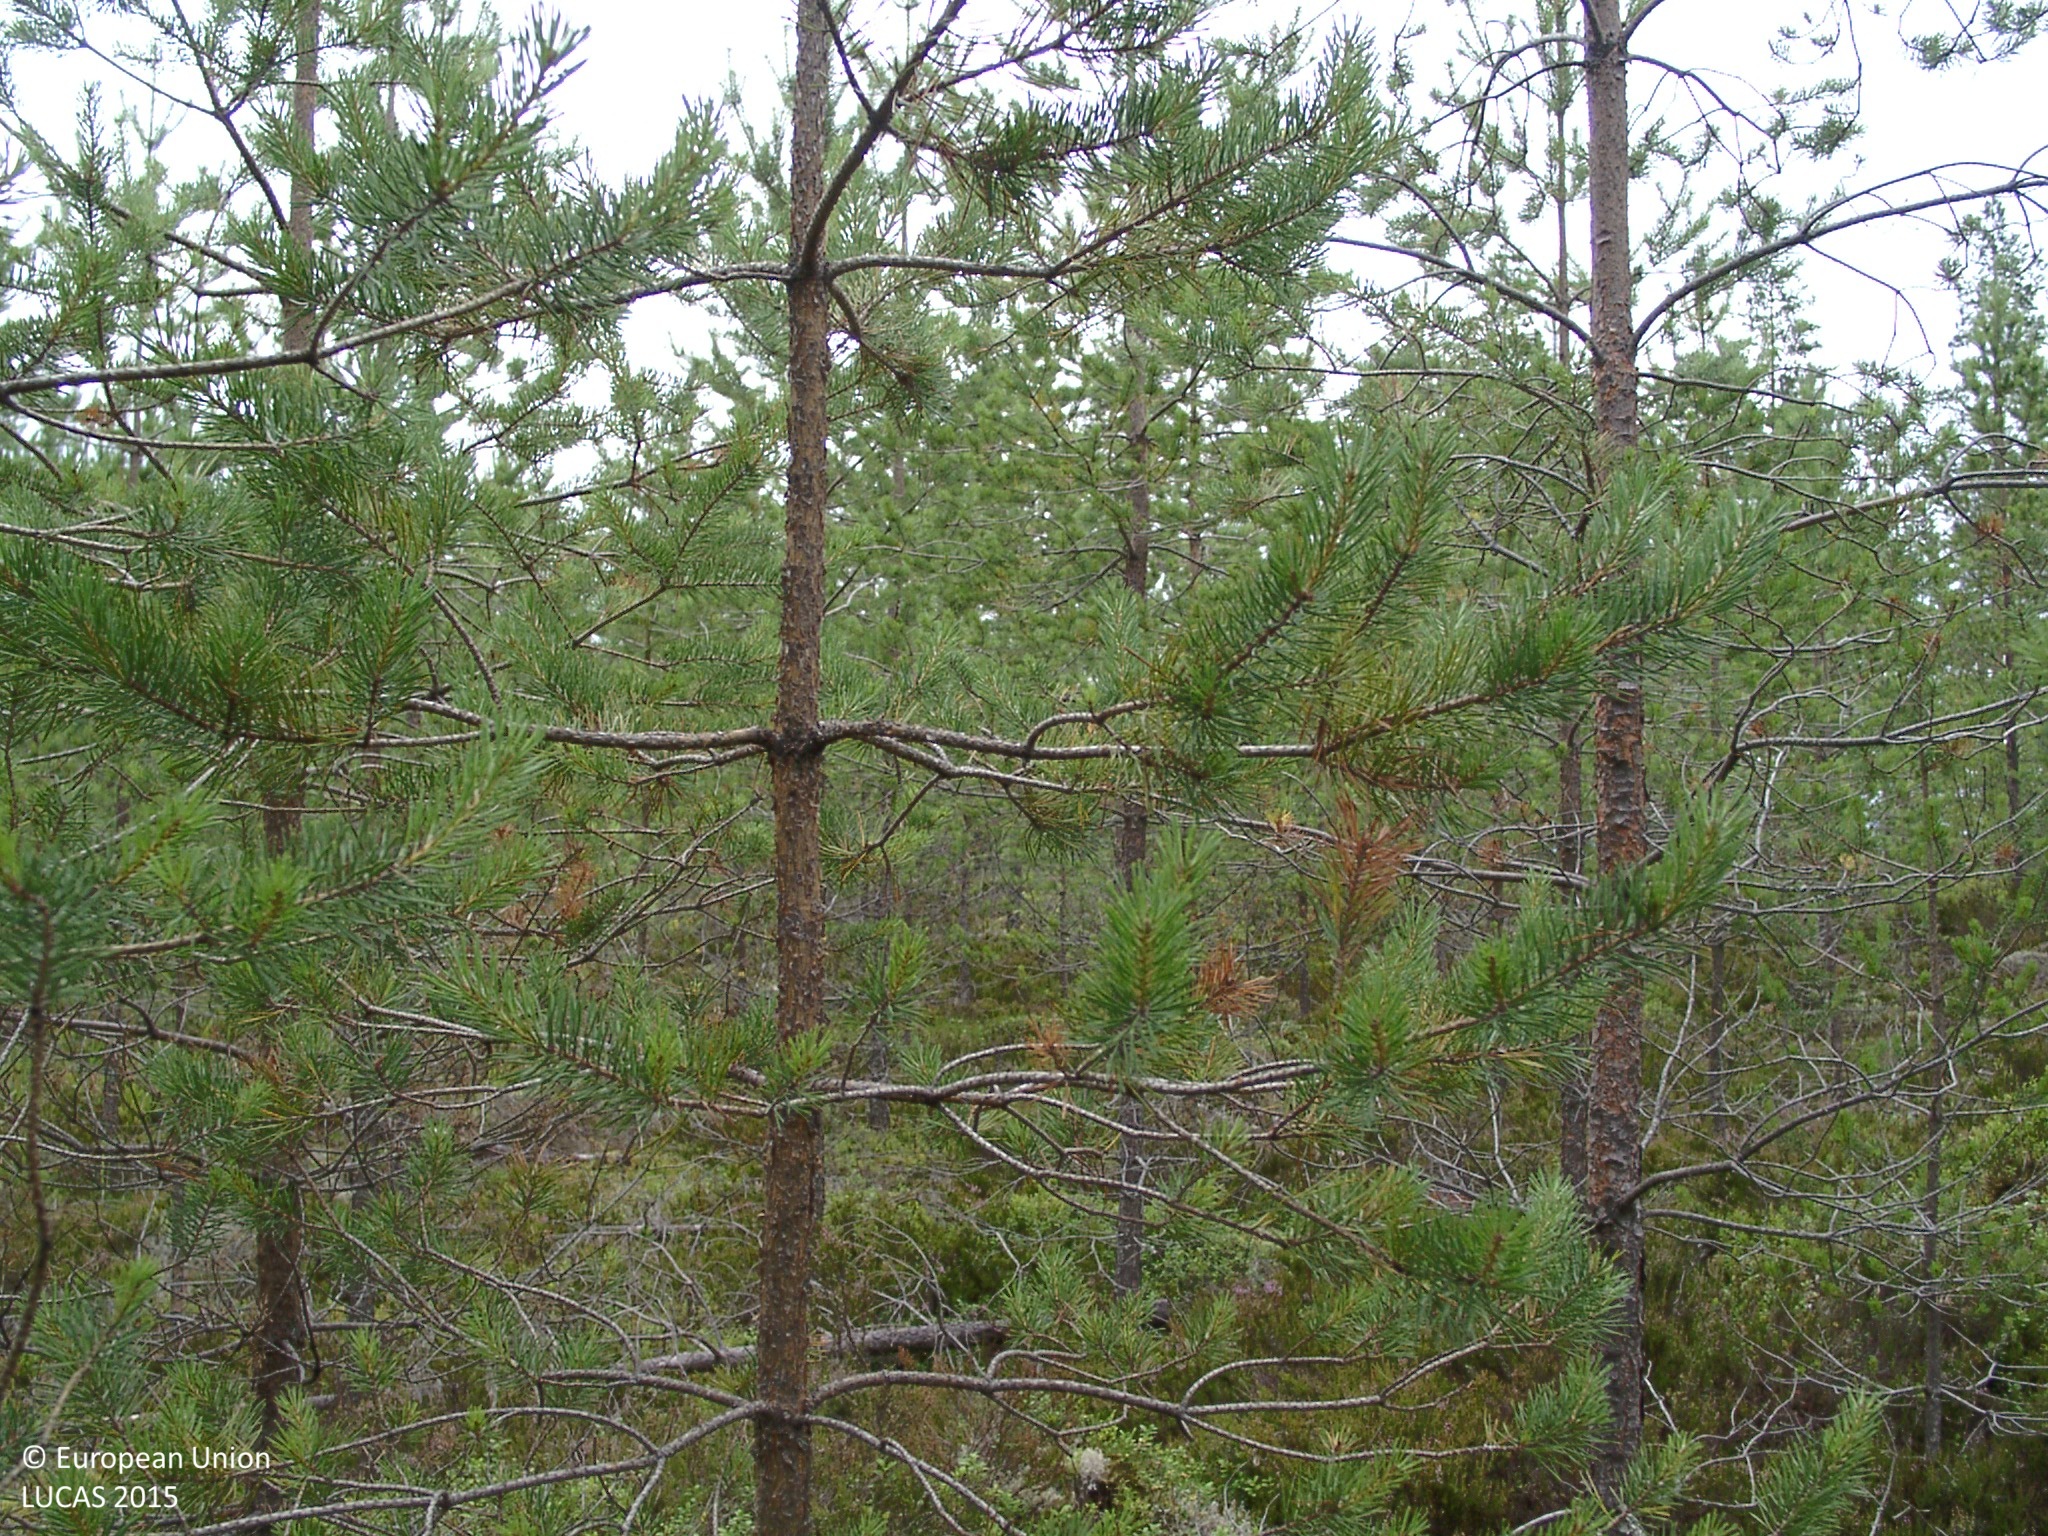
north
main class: Woodland
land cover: Pine dominated coniferous woodland
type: boreal forest
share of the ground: 50 - 75 %
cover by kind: coniferous forest trees 50 %, shrubs 35 %, lichens and mosses 15 %
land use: Forestry
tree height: < 5 m
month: July
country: FI
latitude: 62.7249
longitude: 24.5832
